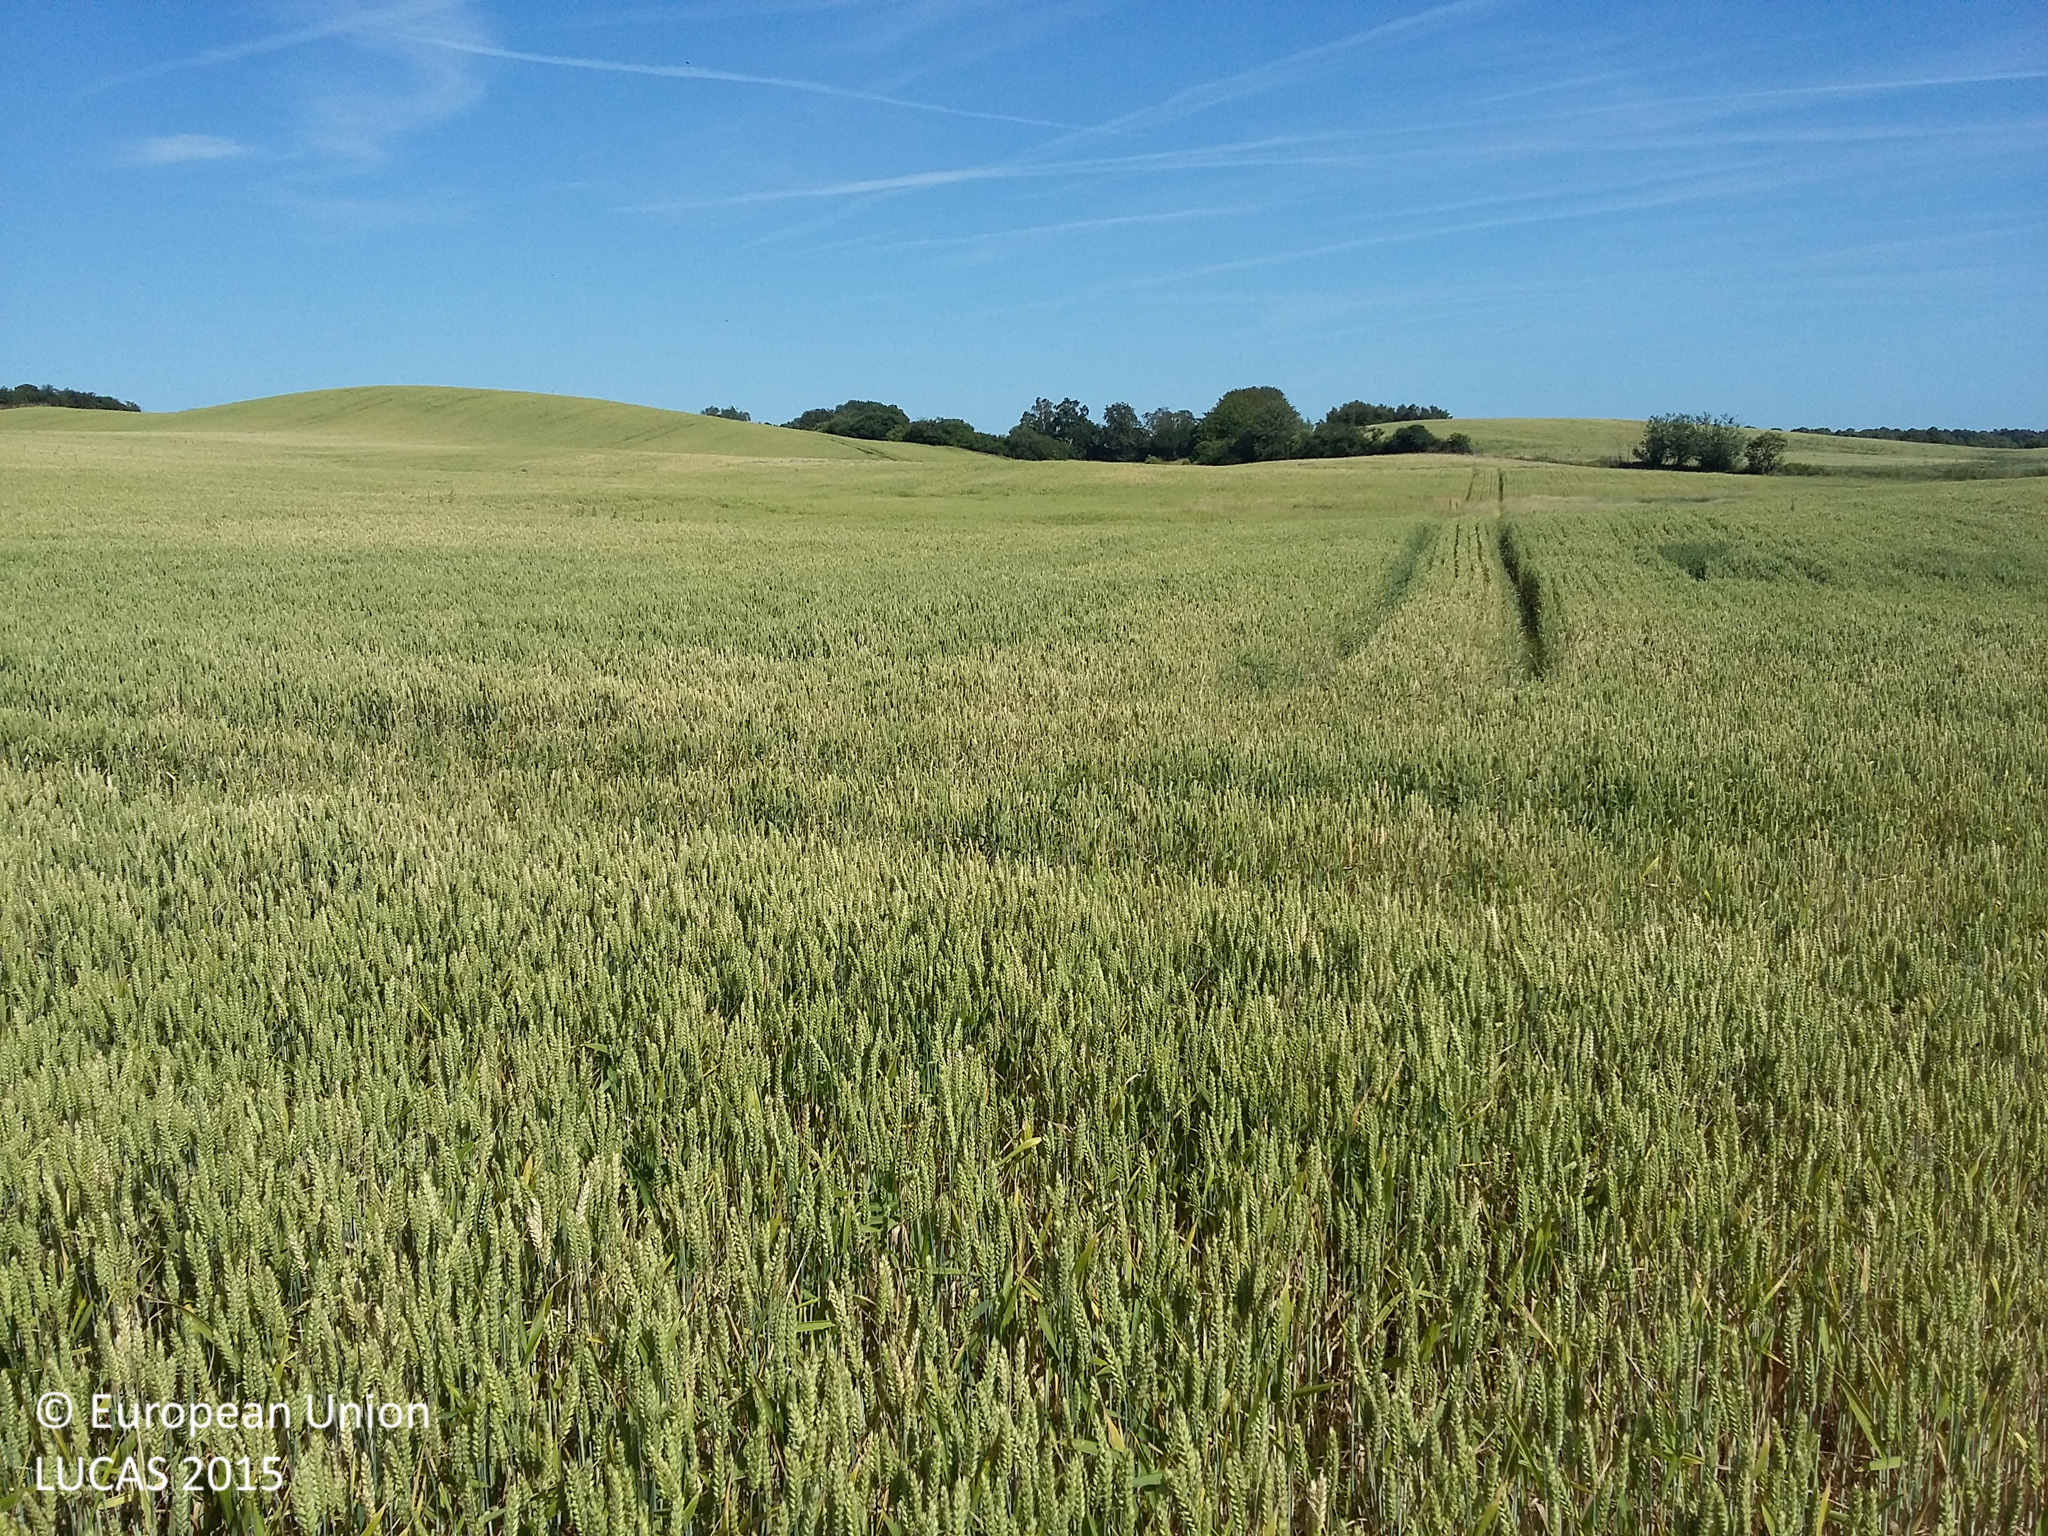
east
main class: Cropland
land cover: Common wheat
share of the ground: > 75 %
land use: Agriculture (excluding fallow land and kitchen gardens)
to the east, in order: Common wheat; Grassland without tree/shrub cover; Common wheat; Grassland without tree/shrub cover; Common wheat
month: July
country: DK
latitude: 55.6036
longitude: 11.5065
